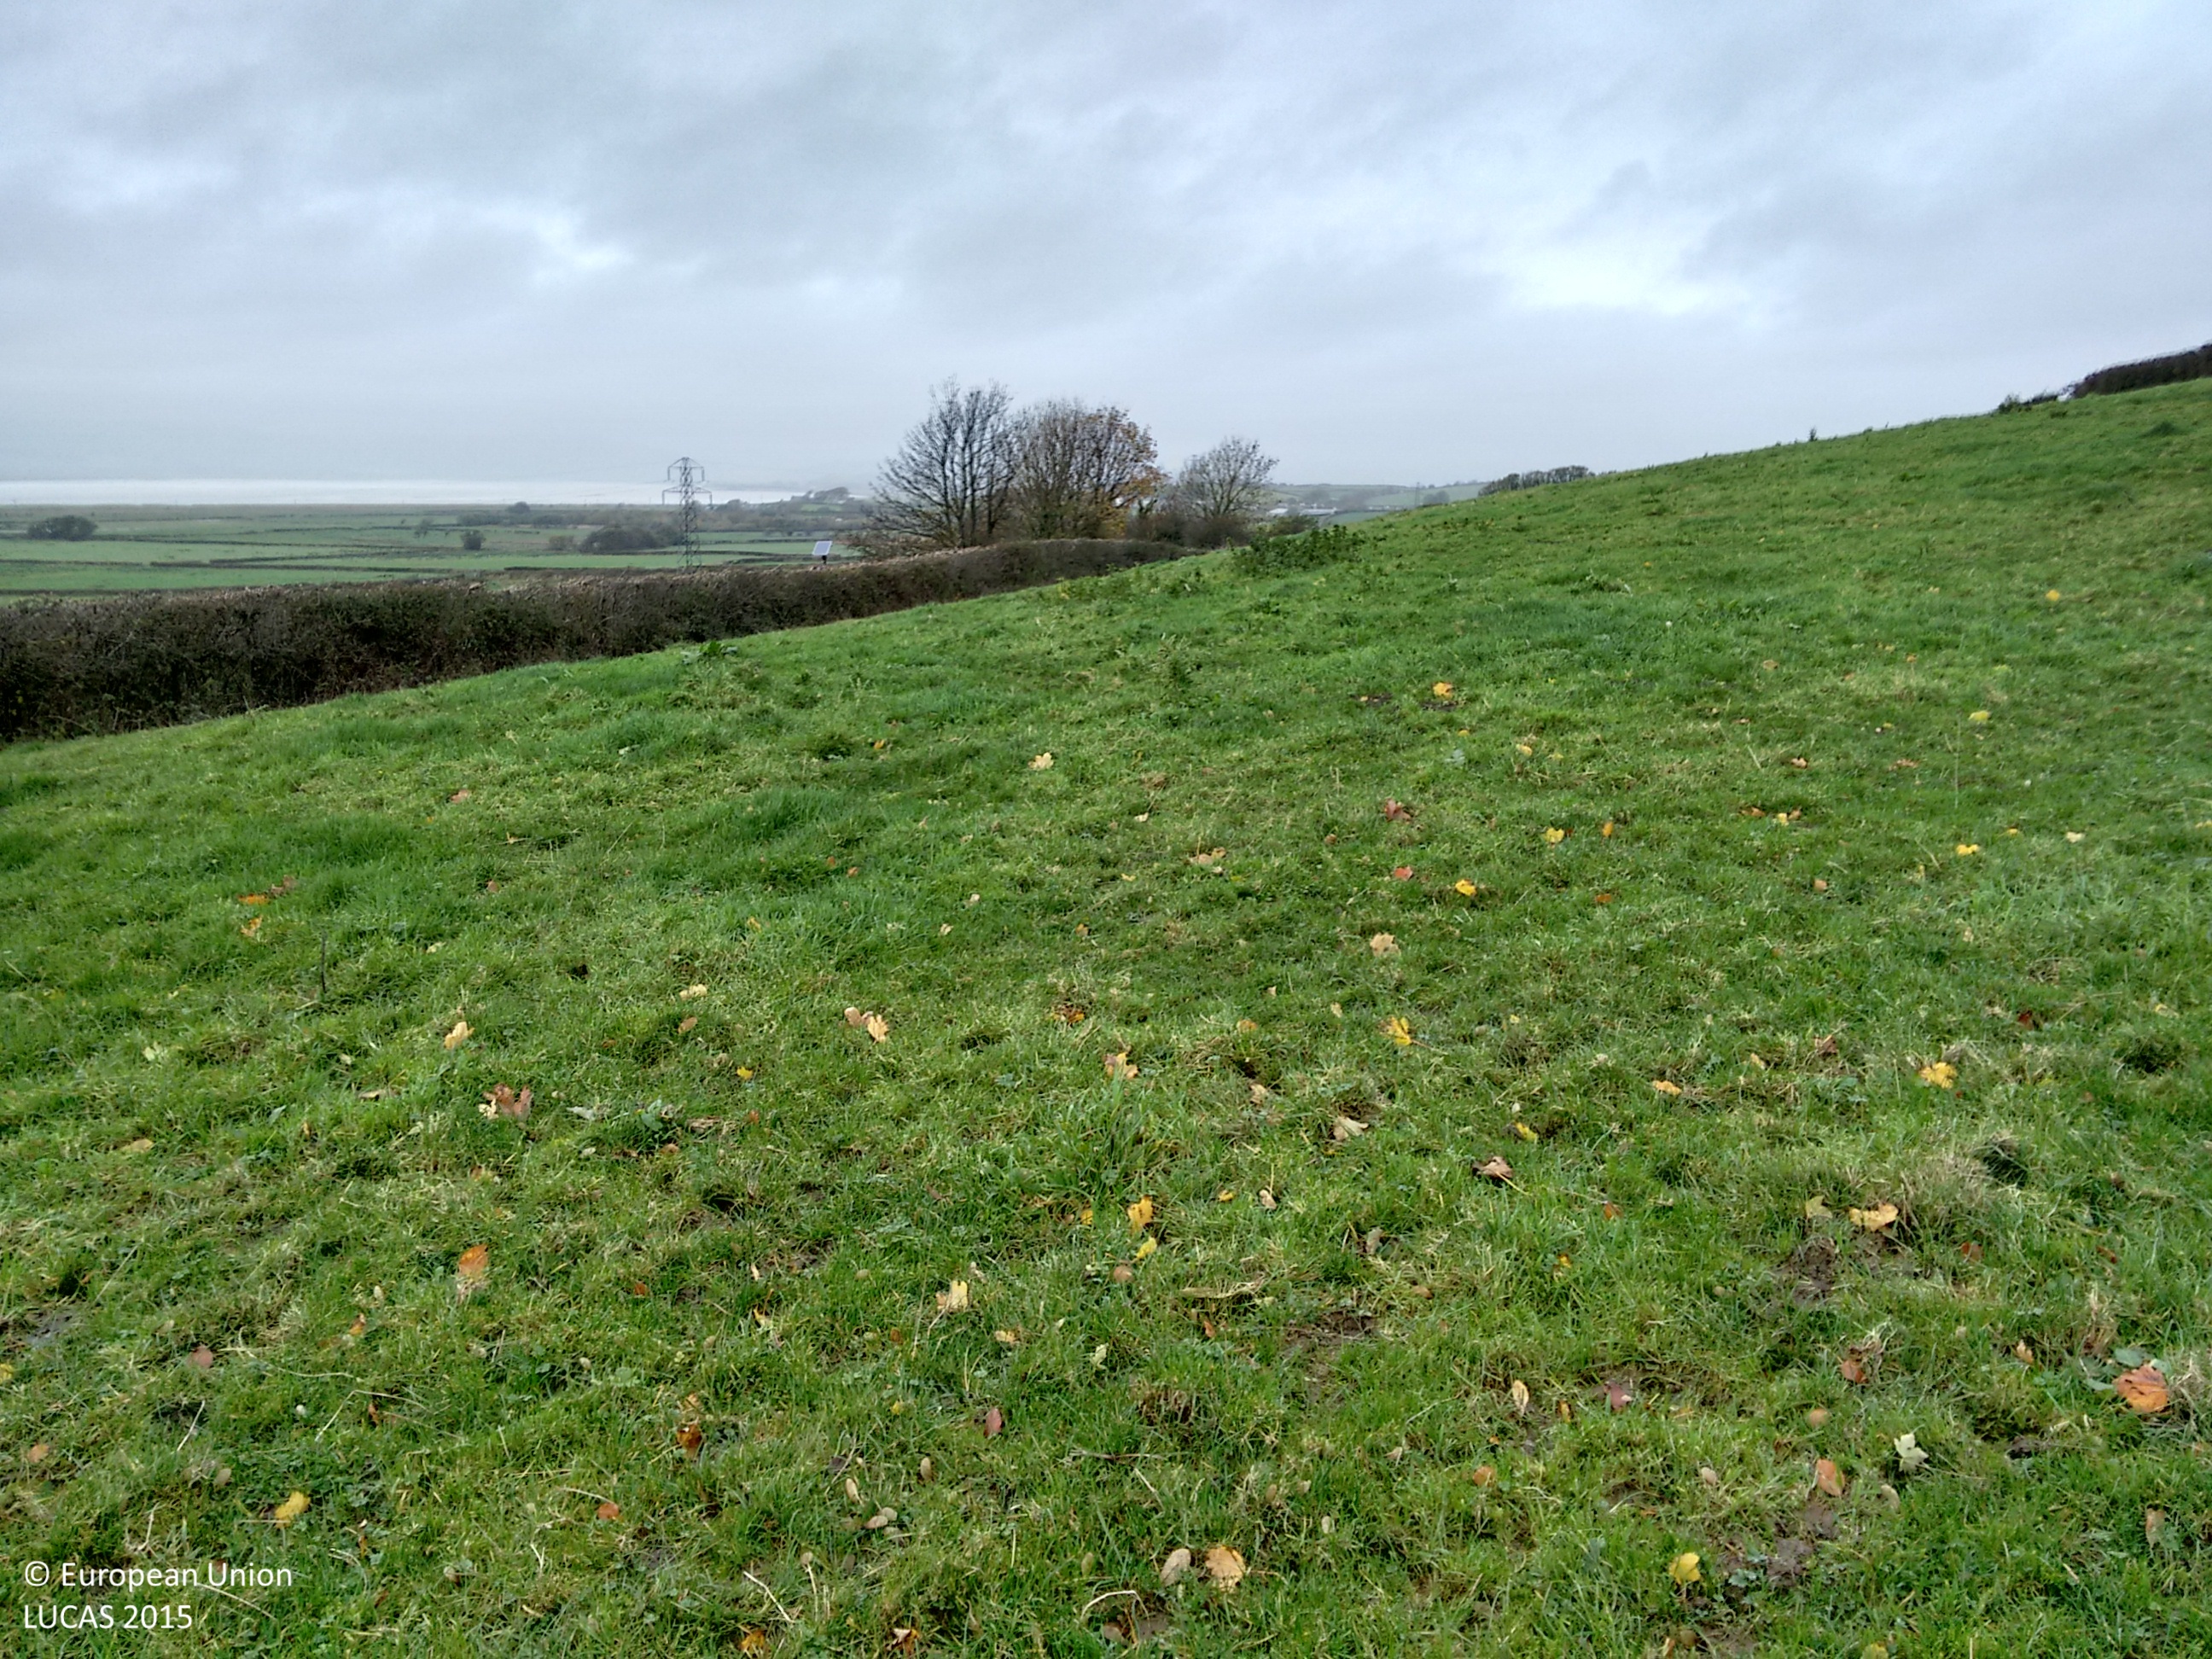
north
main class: Grassland
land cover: Grassland without tree/shrub cover
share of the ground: > 75 %
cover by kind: herbaceous plants 100 %
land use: Agriculture (excluding fallow land and kitchen gardens)
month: November
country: GB
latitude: 54.2083
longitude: -3.1856
